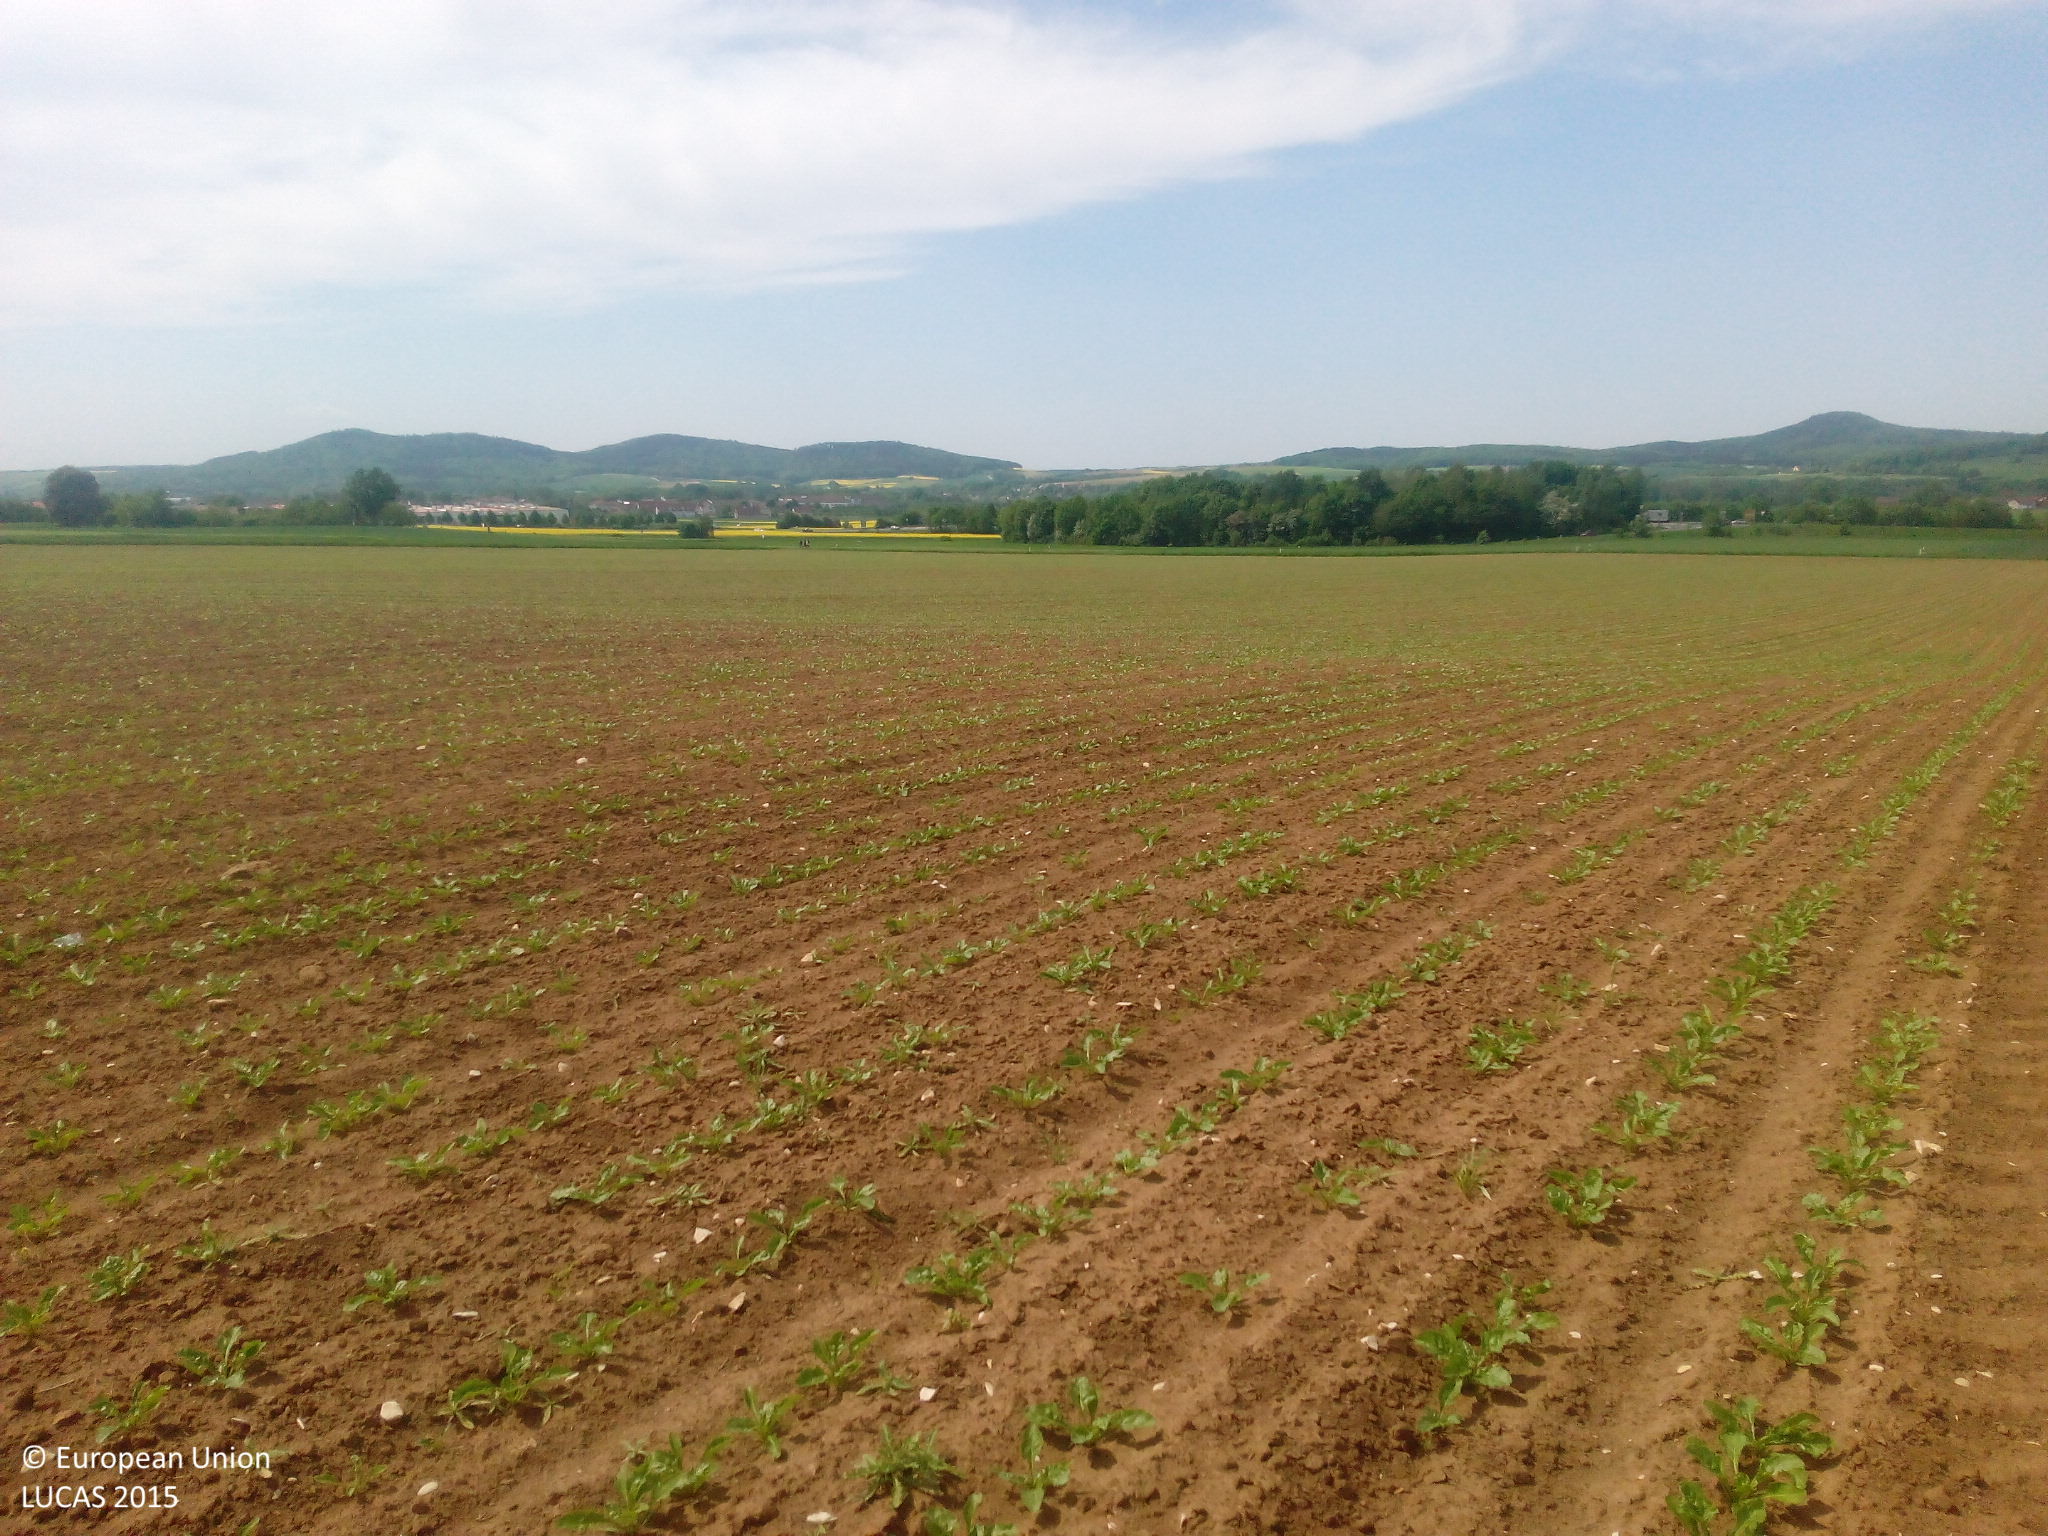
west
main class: Cropland
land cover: Dry pulses
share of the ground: > 75 %
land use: Agriculture (excluding fallow land and kitchen gardens)
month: May
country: DE
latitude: 50.1077
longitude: 11.0204
